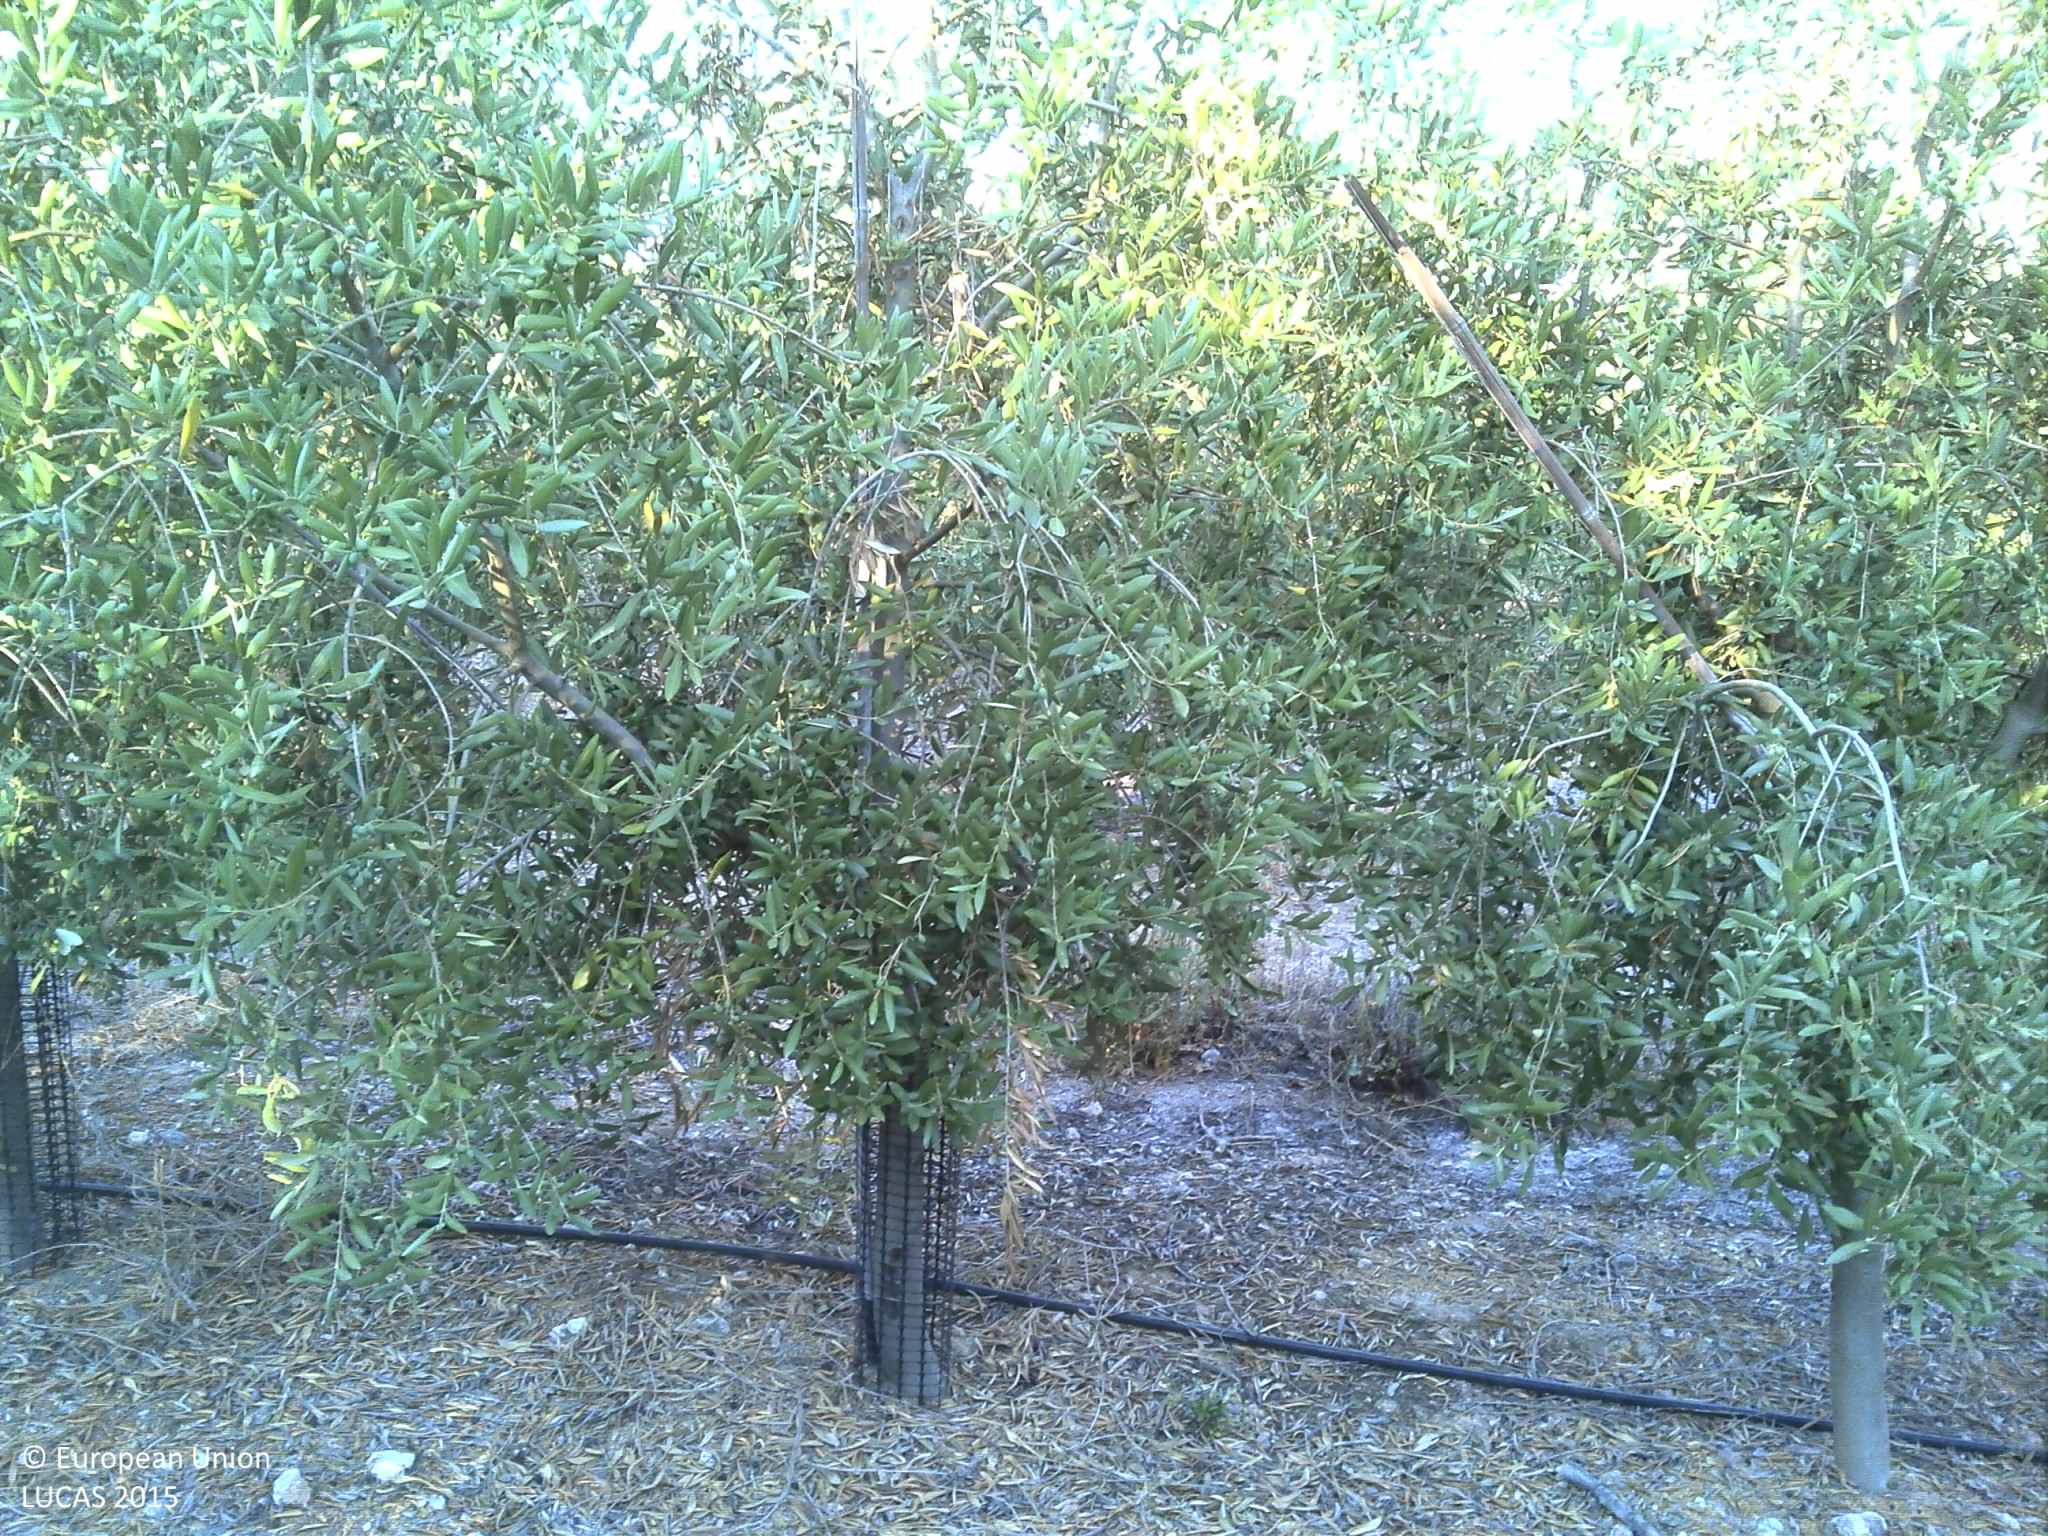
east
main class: Cropland
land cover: Olive groves
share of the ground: 50 - 75 %
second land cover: Grassland without tree/shrub cover
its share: 10 - 25 %
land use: Agriculture (excluding fallow land and kitchen gardens)
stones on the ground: < 10 %
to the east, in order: Olive groves; Grassland without tree/shrub cover; Olive groves; Other bare soil; Grass margins; Ditches and canals; Grass margins; Fences; Grass margins; Other bare soil; Tracks; Grassland without tree/shrub cover; Shrubland without tree cover
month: June
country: PT
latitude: 38.3162
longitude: -7.3727
